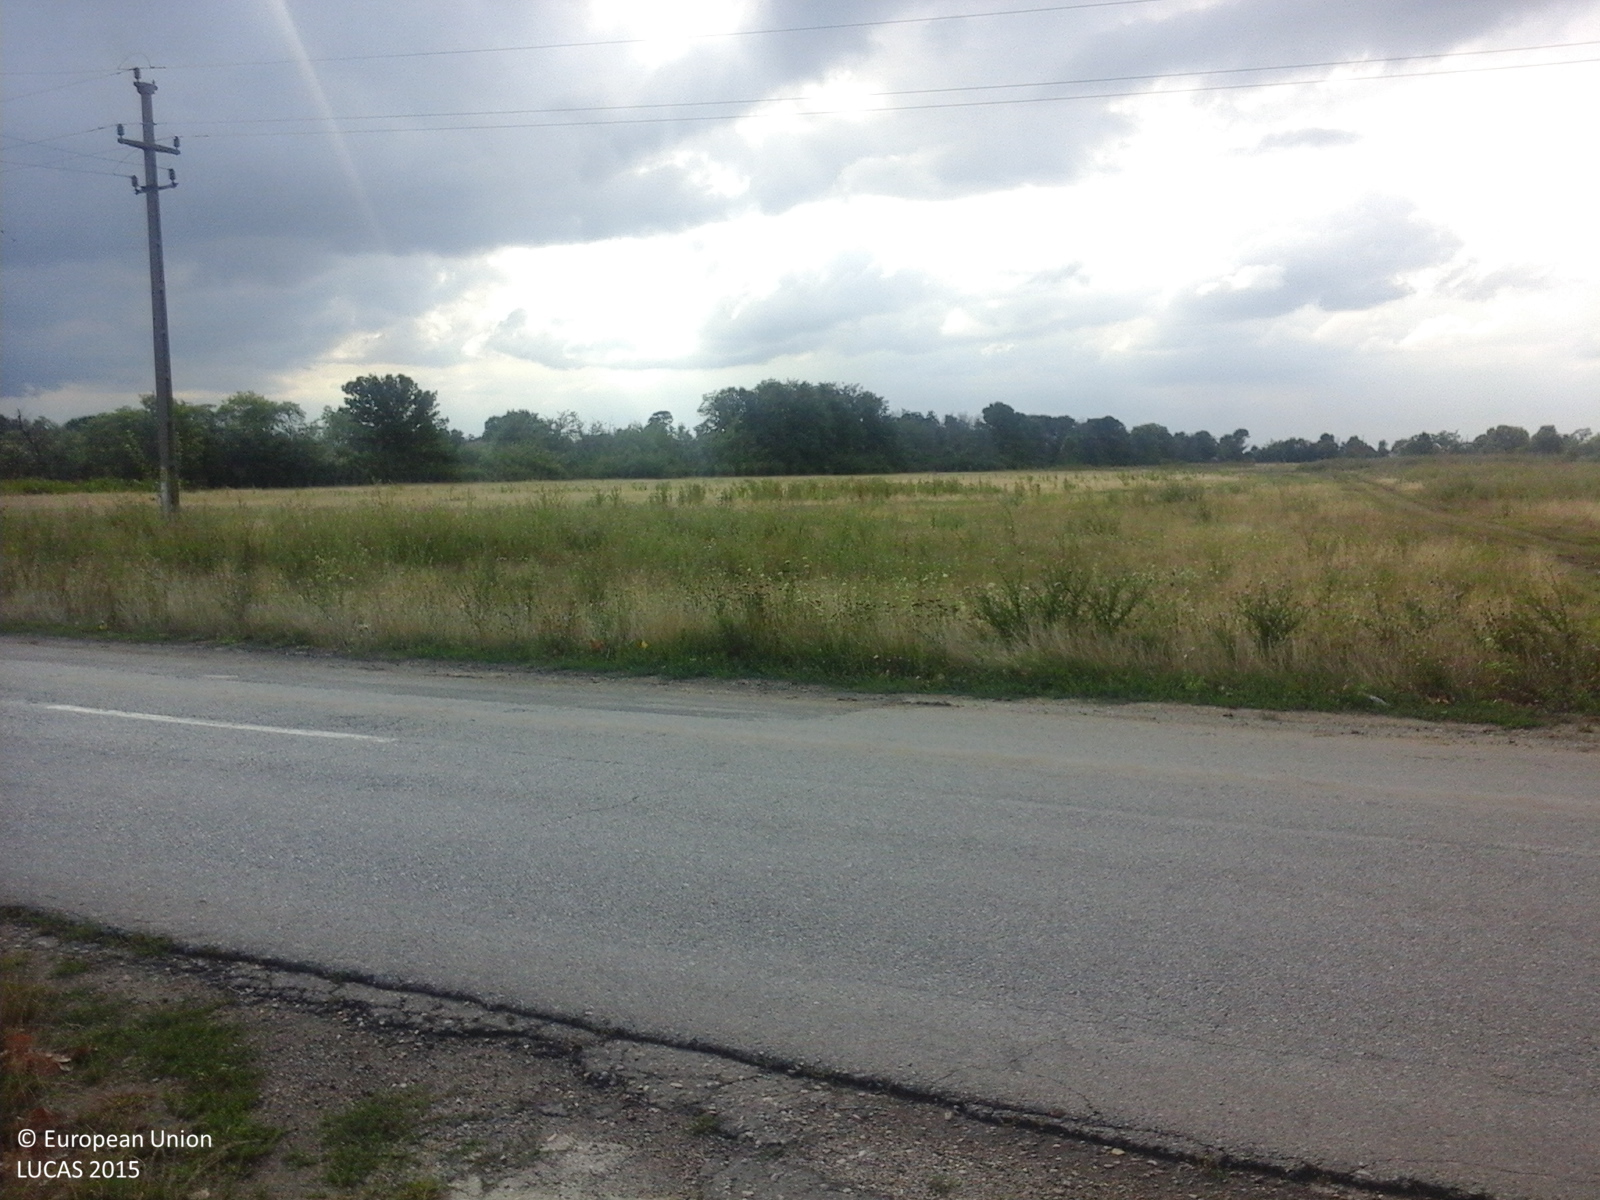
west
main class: Grassland
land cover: Grassland without tree/shrub cover
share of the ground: > 75 %
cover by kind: herbaceous plants 100 %
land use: Agriculture (excluding fallow land and kitchen gardens)
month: August
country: RO
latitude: 45.6116
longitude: 21.4058
